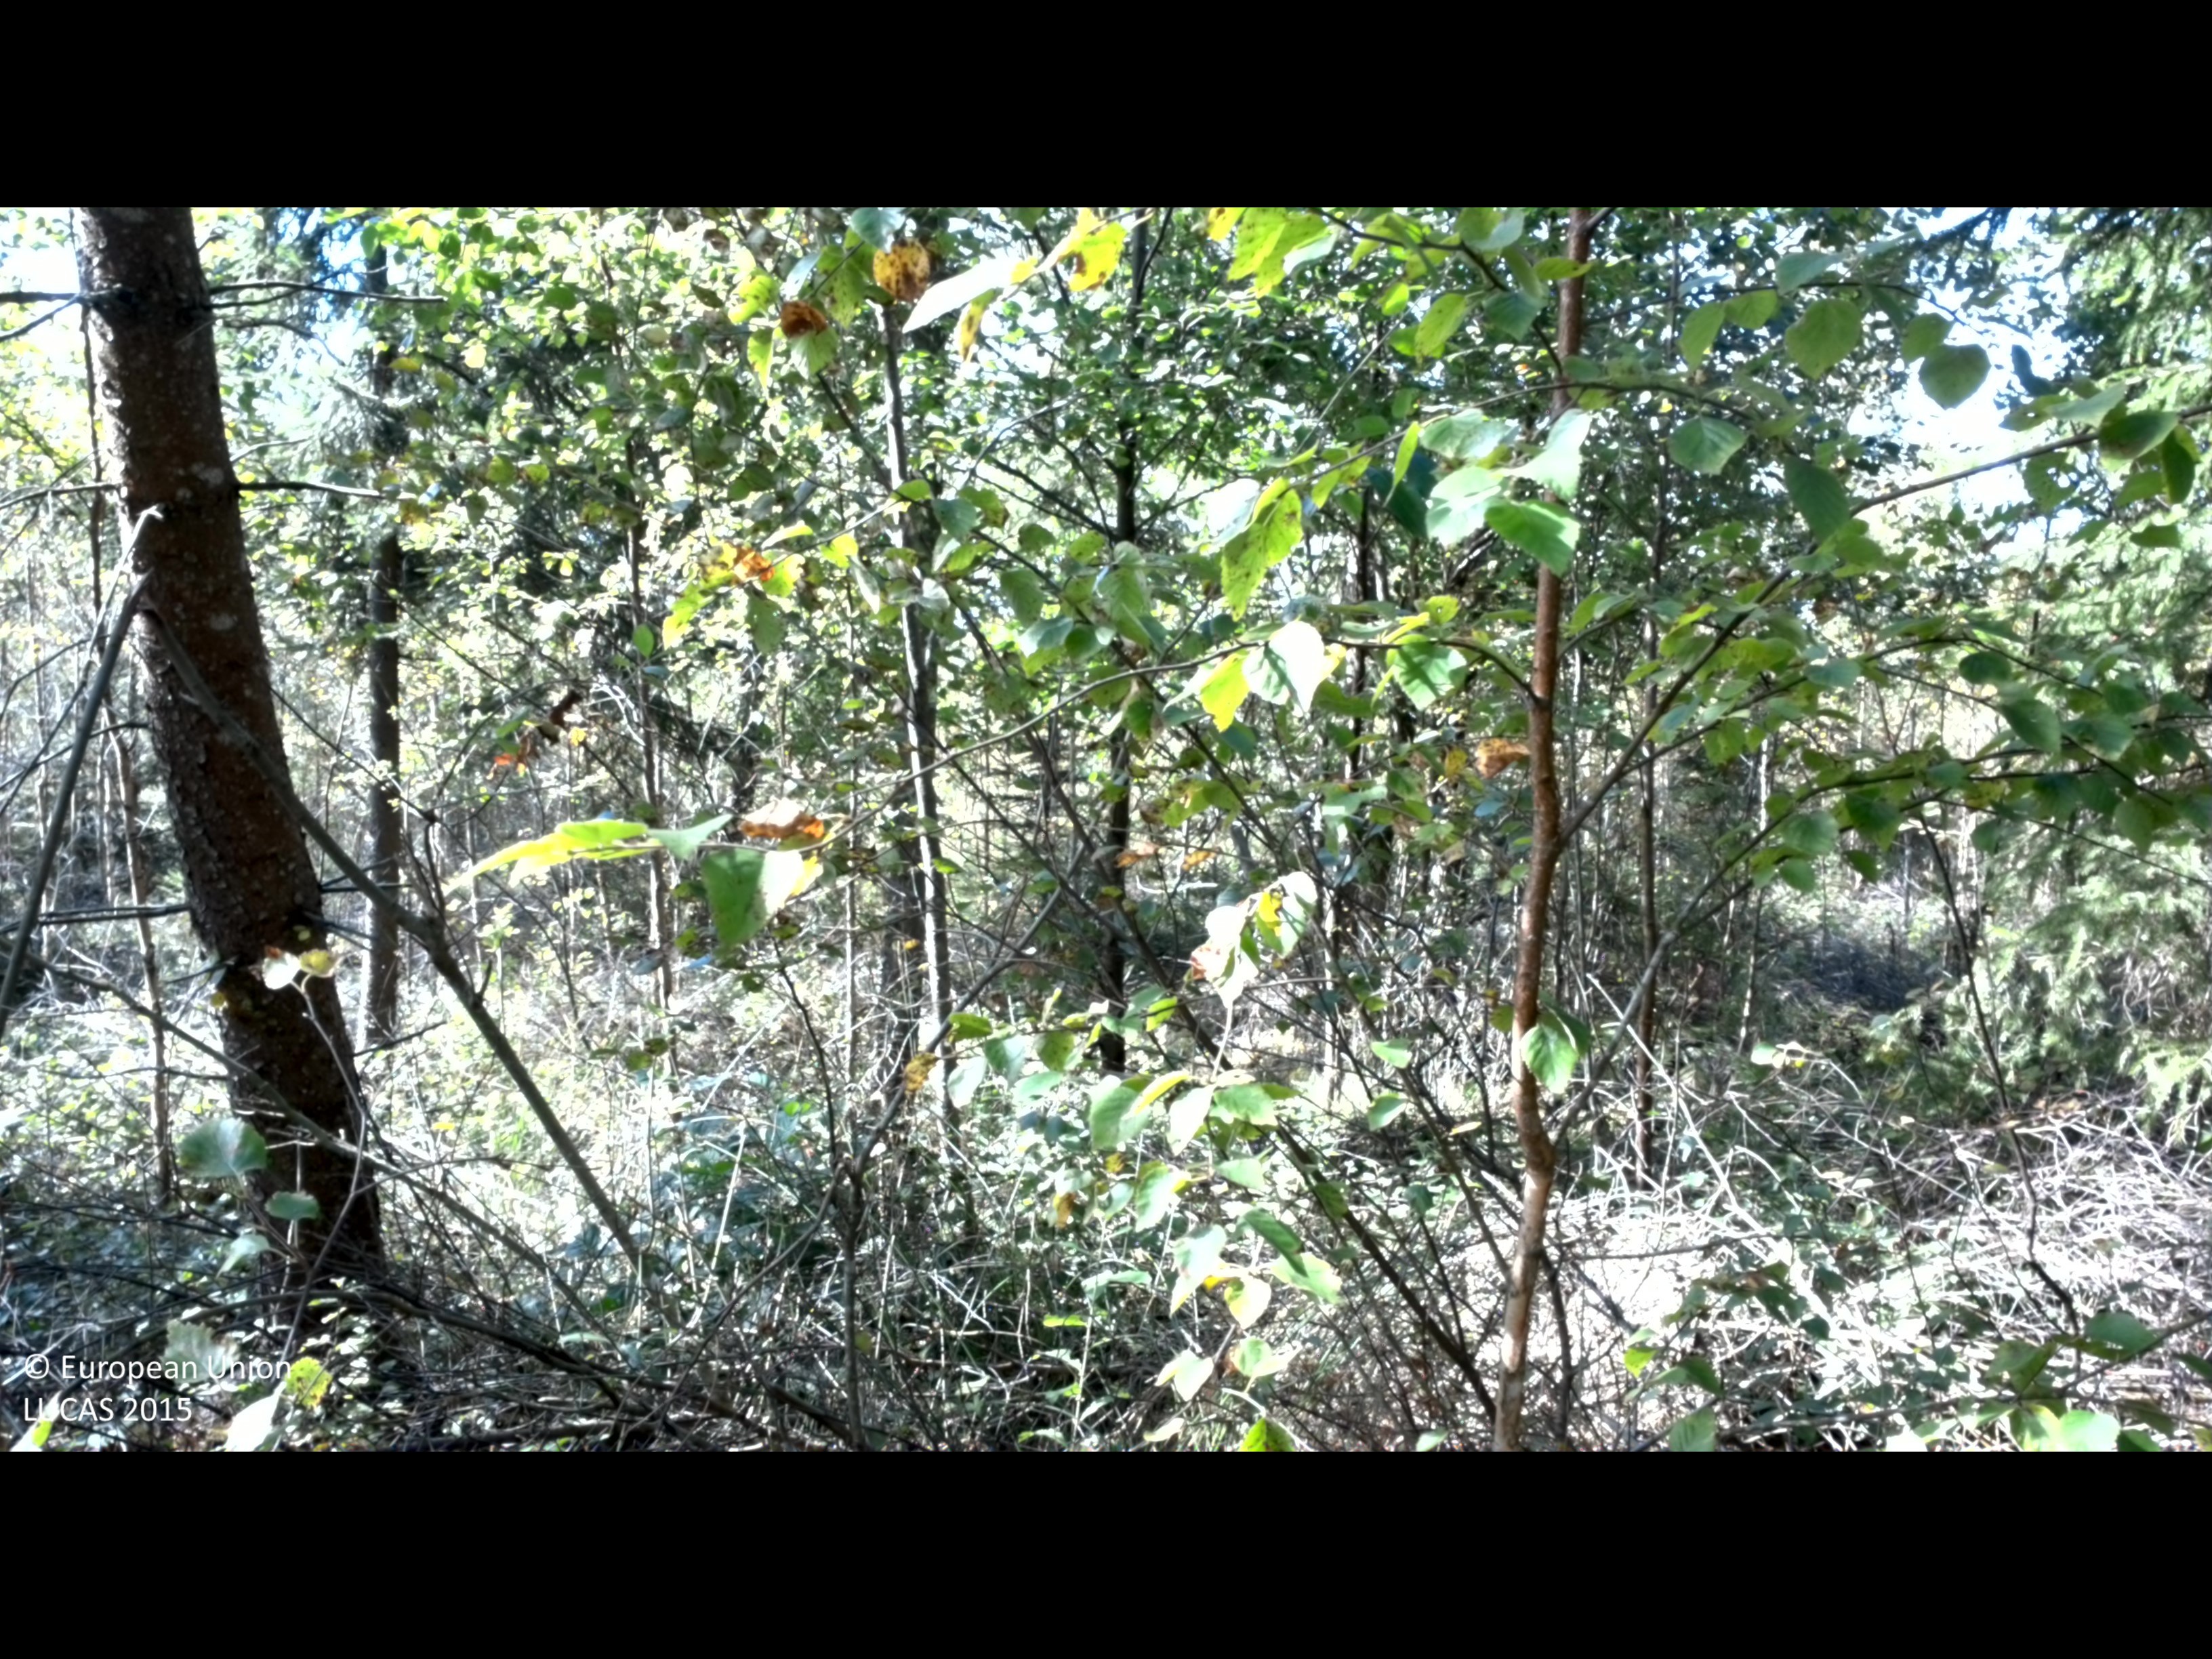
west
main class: Woodland
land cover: Spruce dominated mixed woodland
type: boreal forest
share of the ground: > 75 %
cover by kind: broadleaved forest trees 45 %, coniferous forest trees 35 %, shrubs 10 %, herbaceous plants 5 %, lichens and mosses 5 %
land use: Forestry
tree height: > 5 m
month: September
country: SE
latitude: 57.0130
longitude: 13.1418
